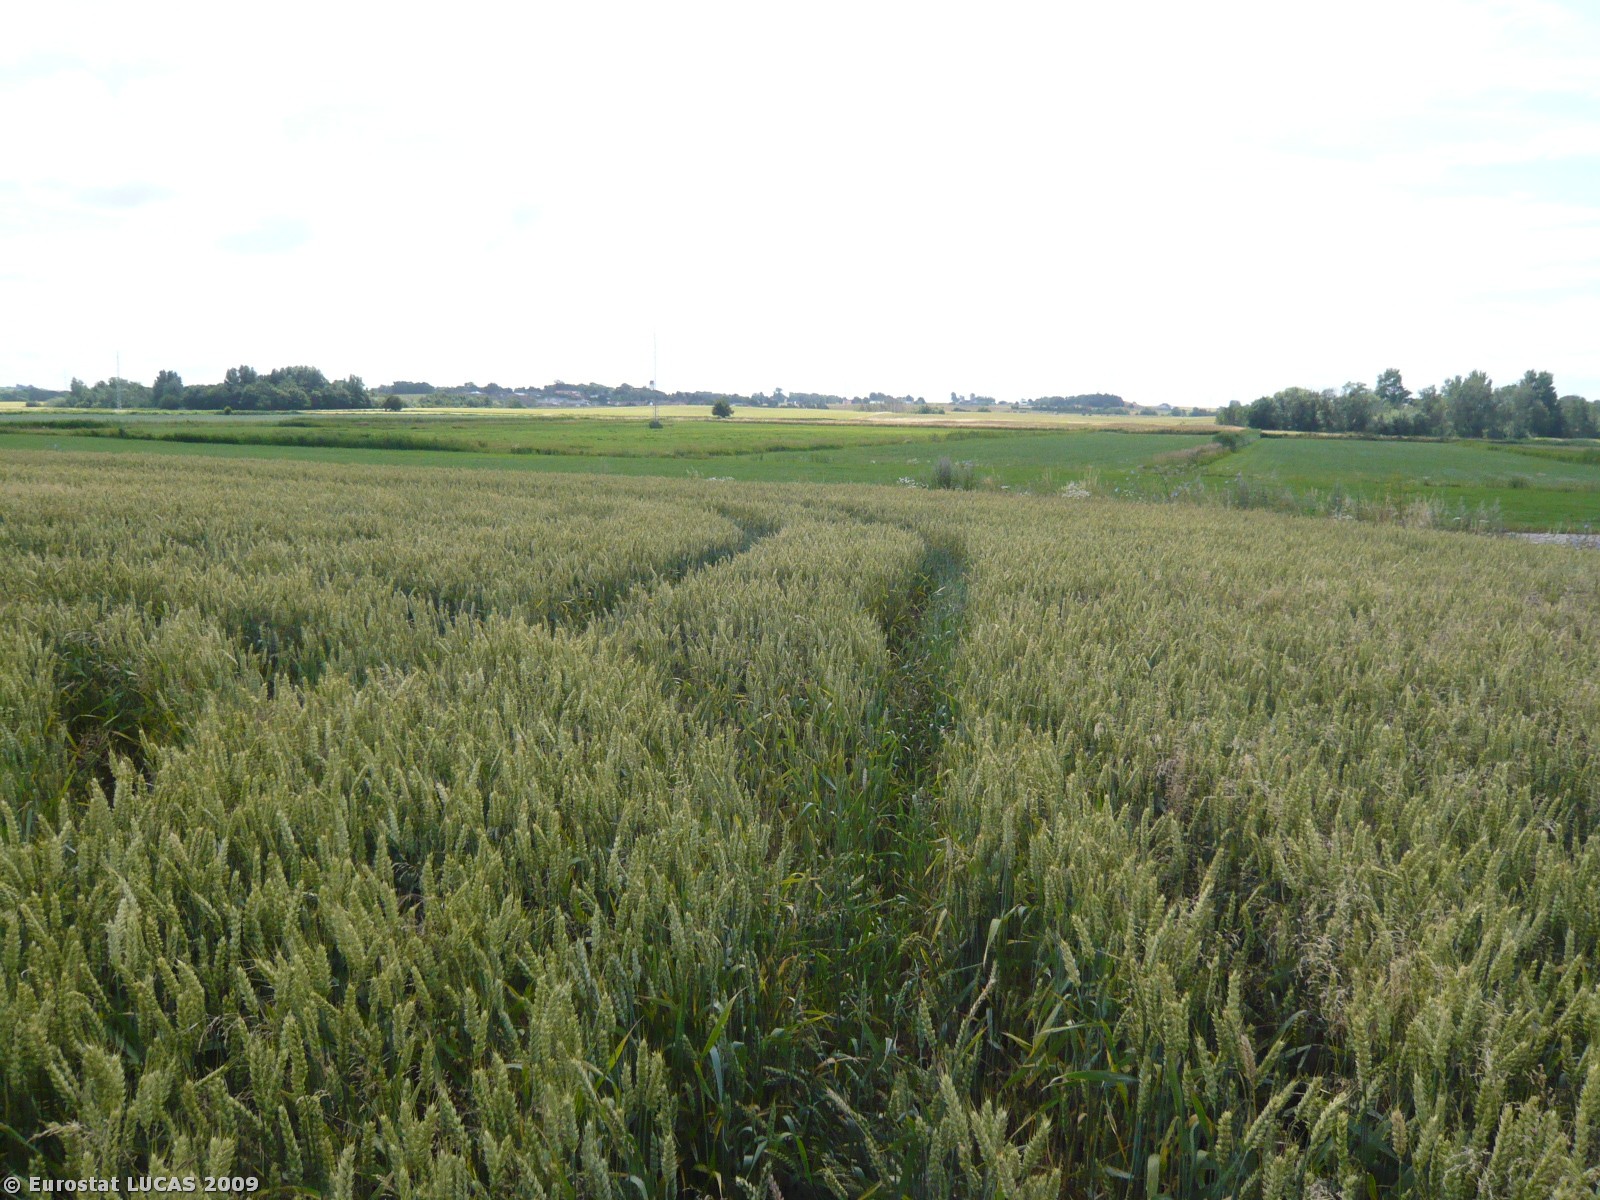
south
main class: Cropland
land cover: Common wheat
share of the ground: > 75 %
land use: Agriculture (excluding fallow land and kitchen gardens)
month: July
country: DK
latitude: 55.6612
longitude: 11.1593
